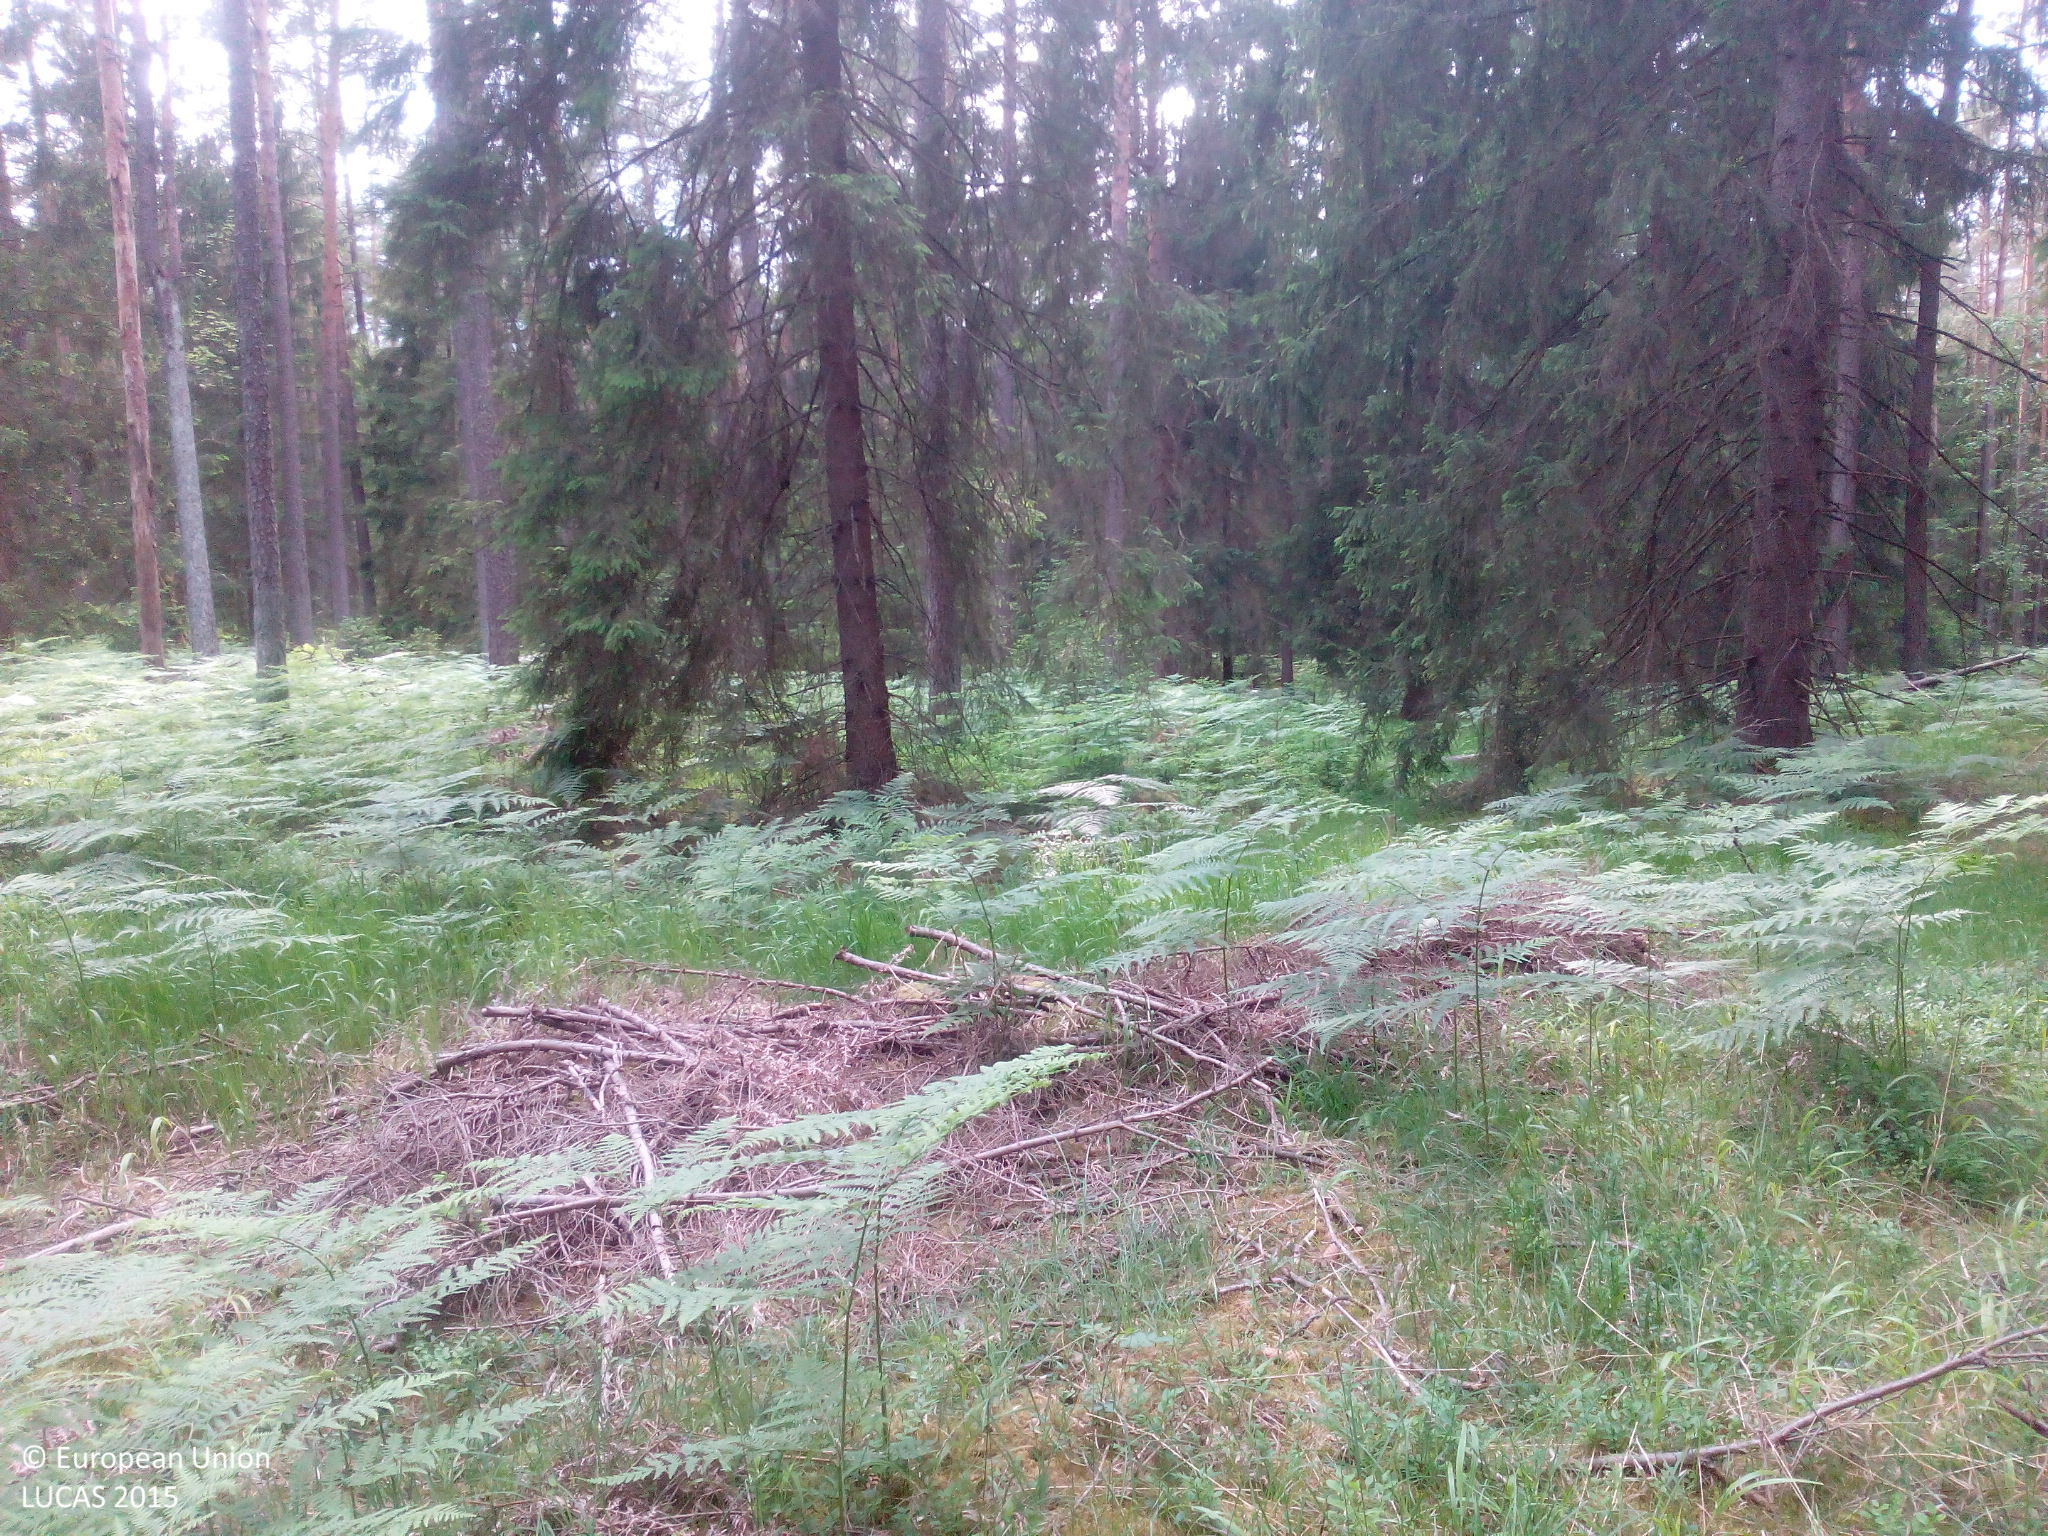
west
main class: Woodland
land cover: Other coniferous woodland
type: hemiboreal forest and nemoral coniferous forest and mixed broadleaved-coniferous forest
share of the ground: 50 - 75 %
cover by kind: coniferous forest trees 70 %, herbaceous plants 25 %, lichens and mosses 5 %
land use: Forestry
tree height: > 5 m
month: June
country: DE
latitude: 49.7069
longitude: 11.4833
